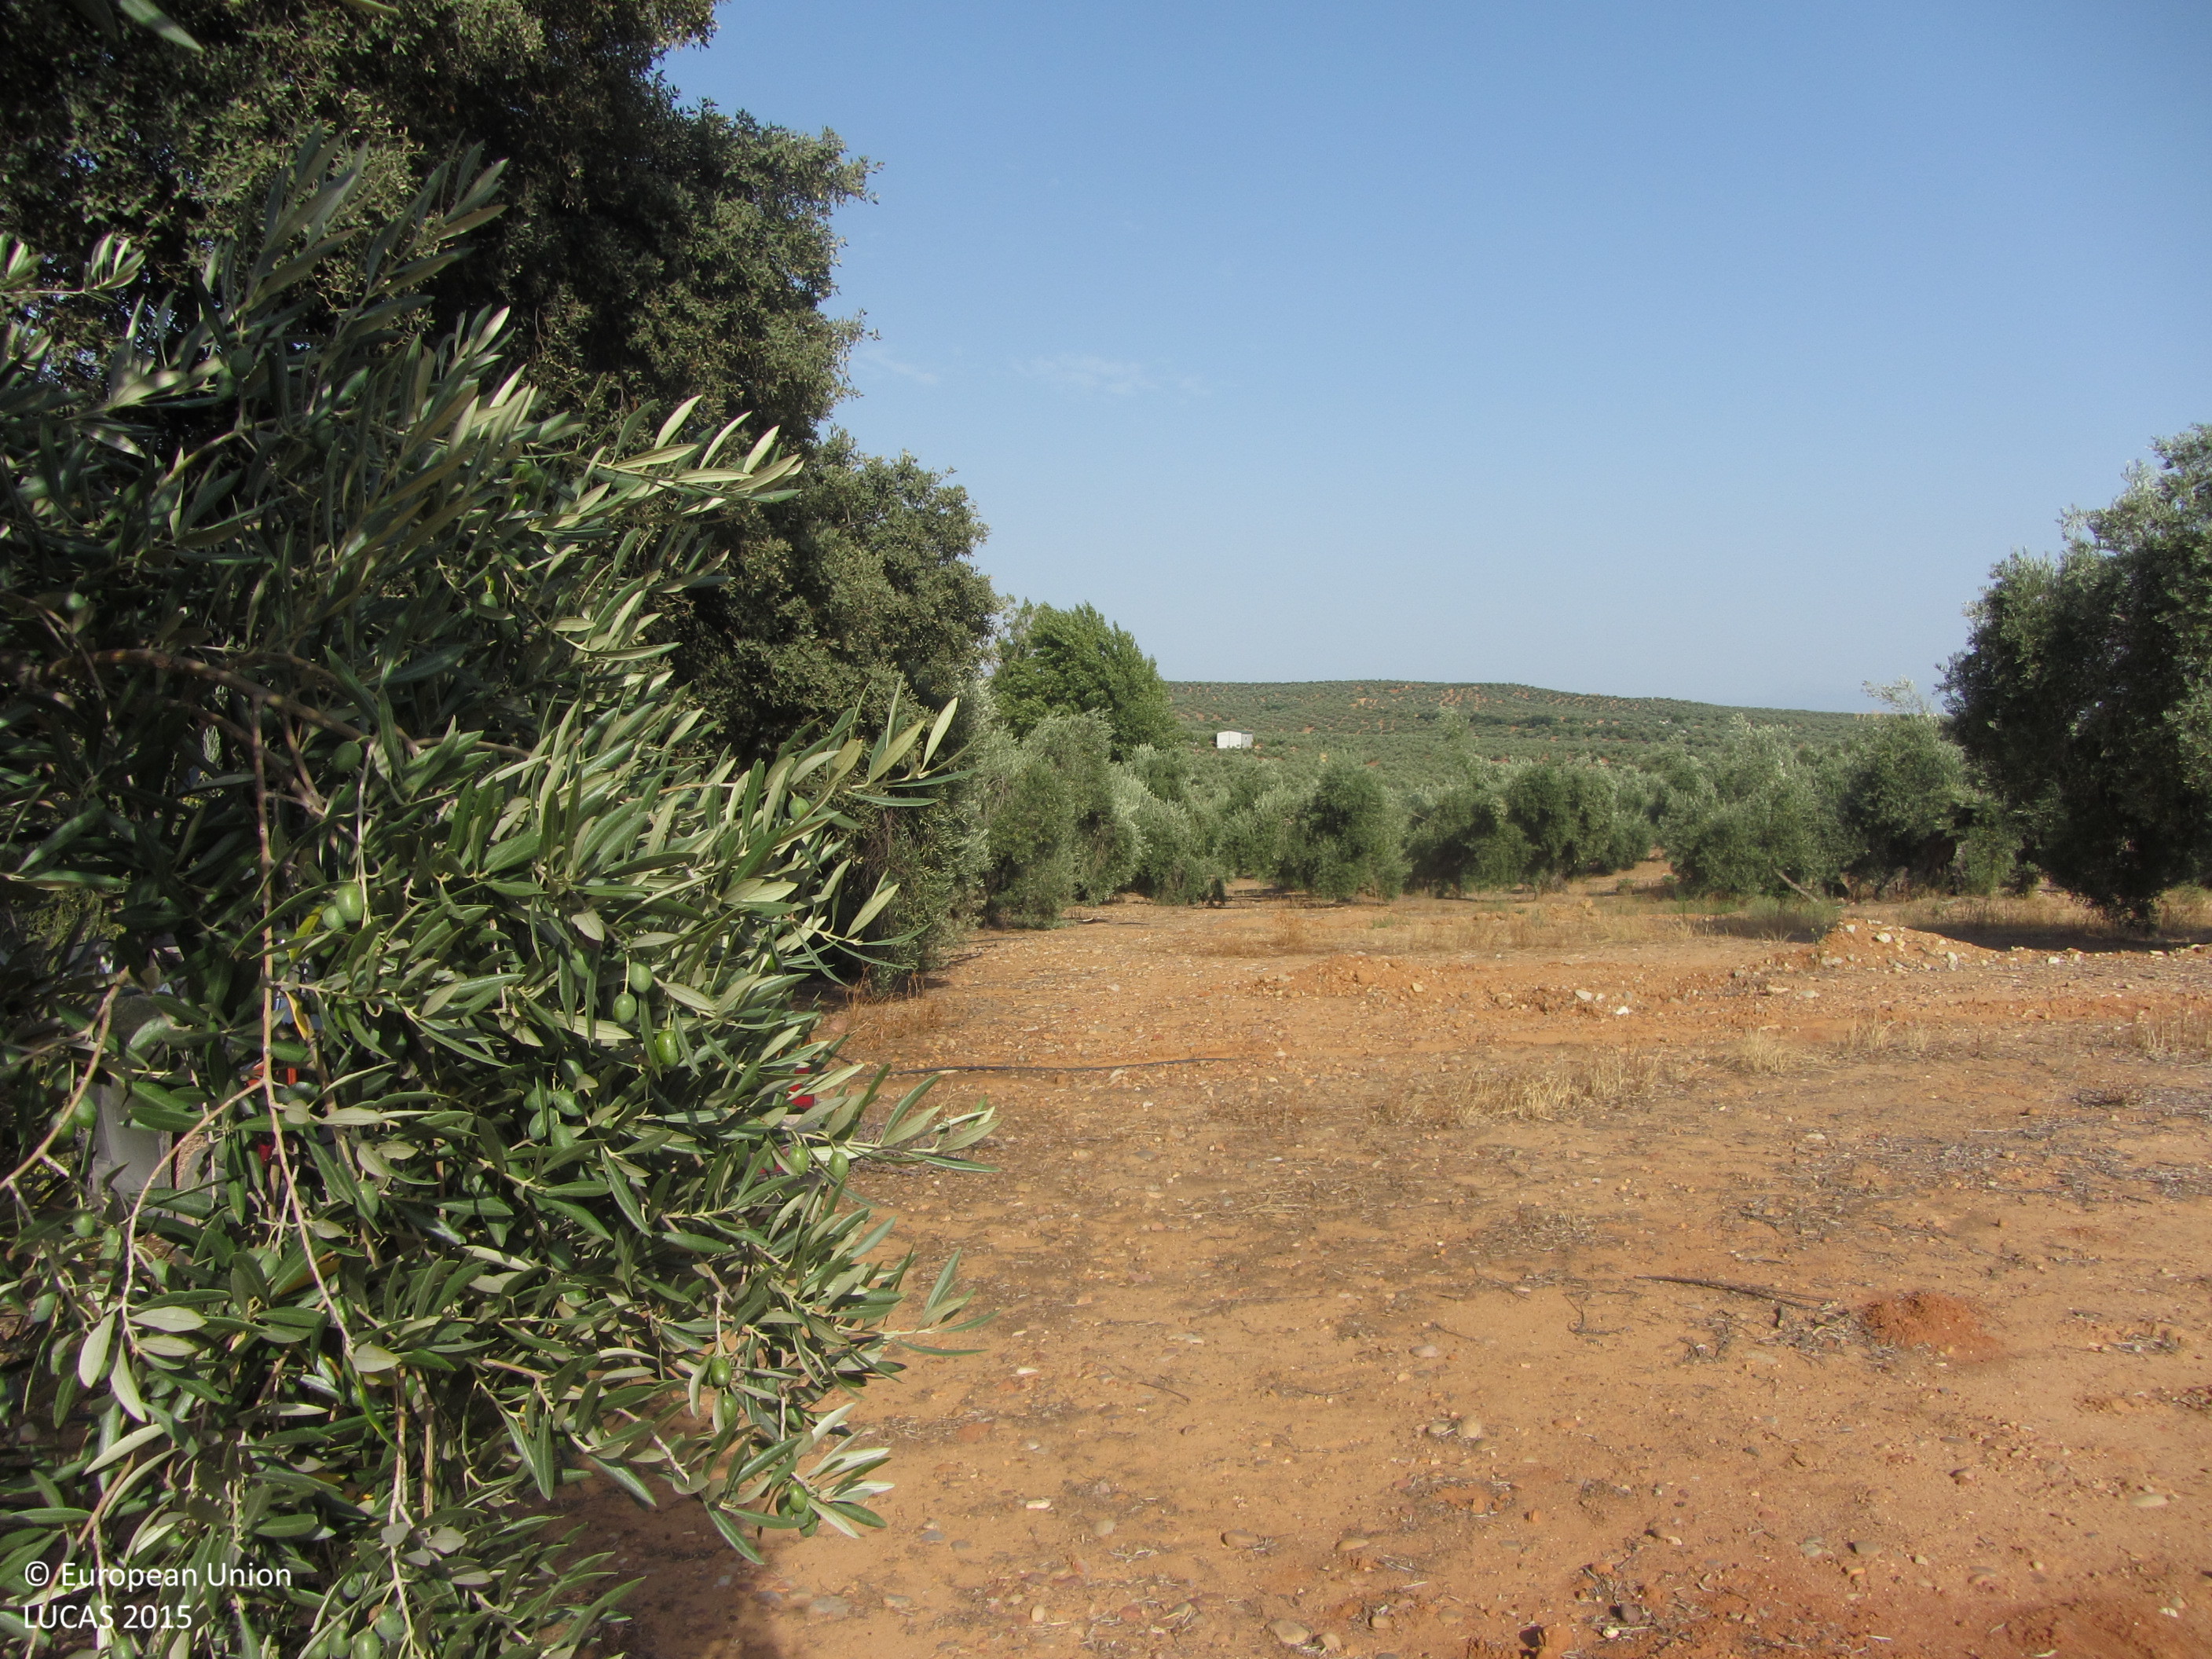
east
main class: Cropland
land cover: Olive groves
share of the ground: 10 - 25 %
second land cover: Other bare soil
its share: > 75 %
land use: Agriculture (excluding fallow land and kitchen gardens)
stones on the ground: < 10 %
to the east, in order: Olive groves; Other bare soil; Broadleaved woodland; Olive groves
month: July
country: ES
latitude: 38.0797
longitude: -3.9037
